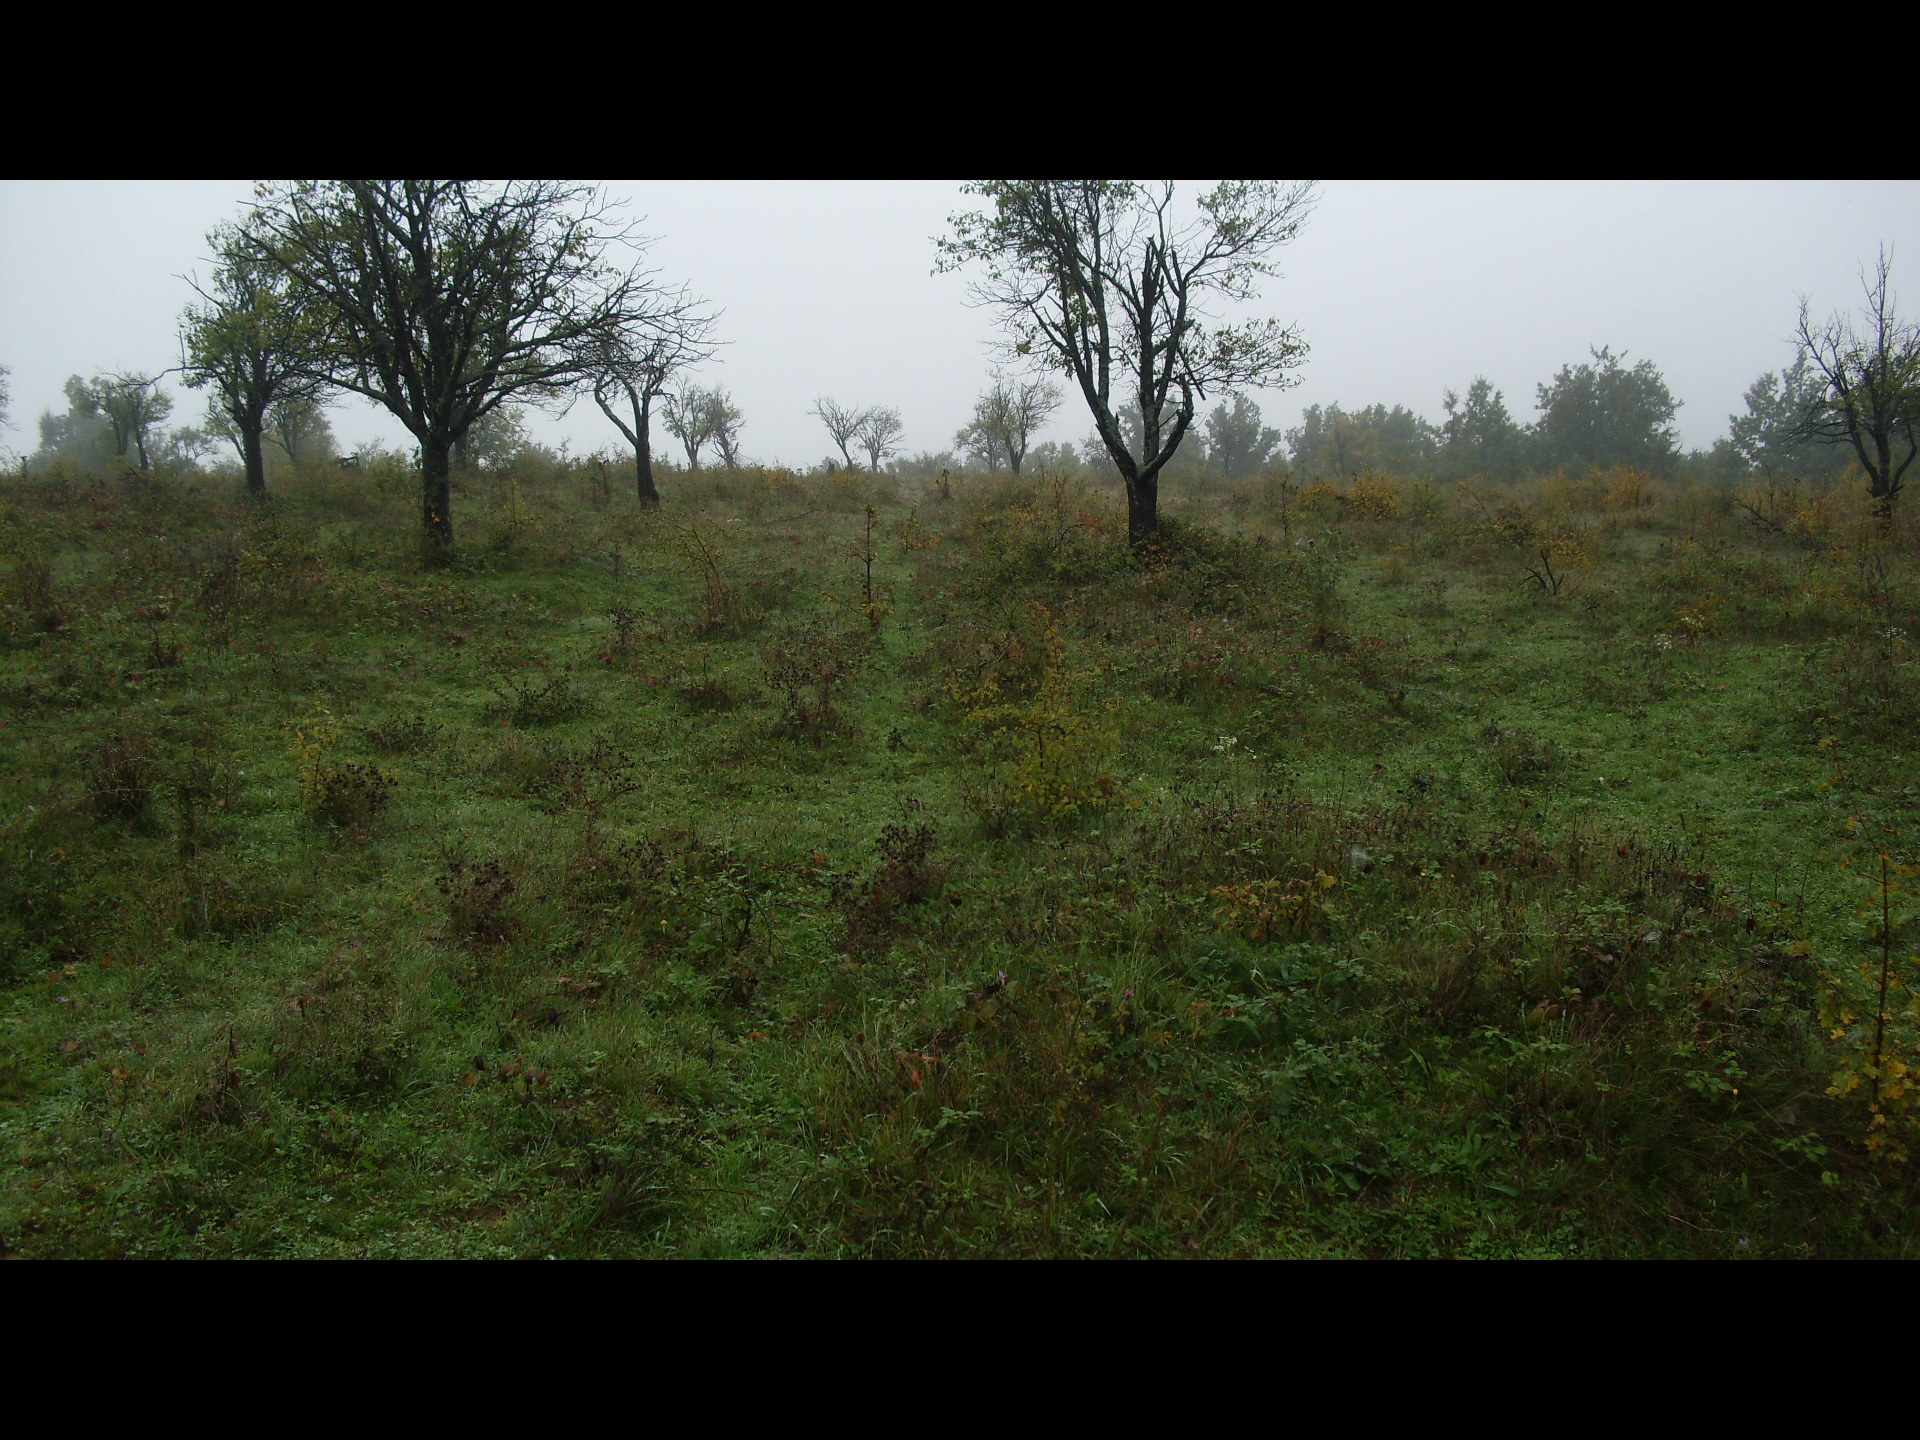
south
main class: Cropland
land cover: Other fruit trees and berries
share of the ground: < 10 %
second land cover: Grassland without tree/shrub cover
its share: > 75 %
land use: Agriculture (excluding fallow land and kitchen gardens)
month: October
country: BG
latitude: 43.7775
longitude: 22.4692
